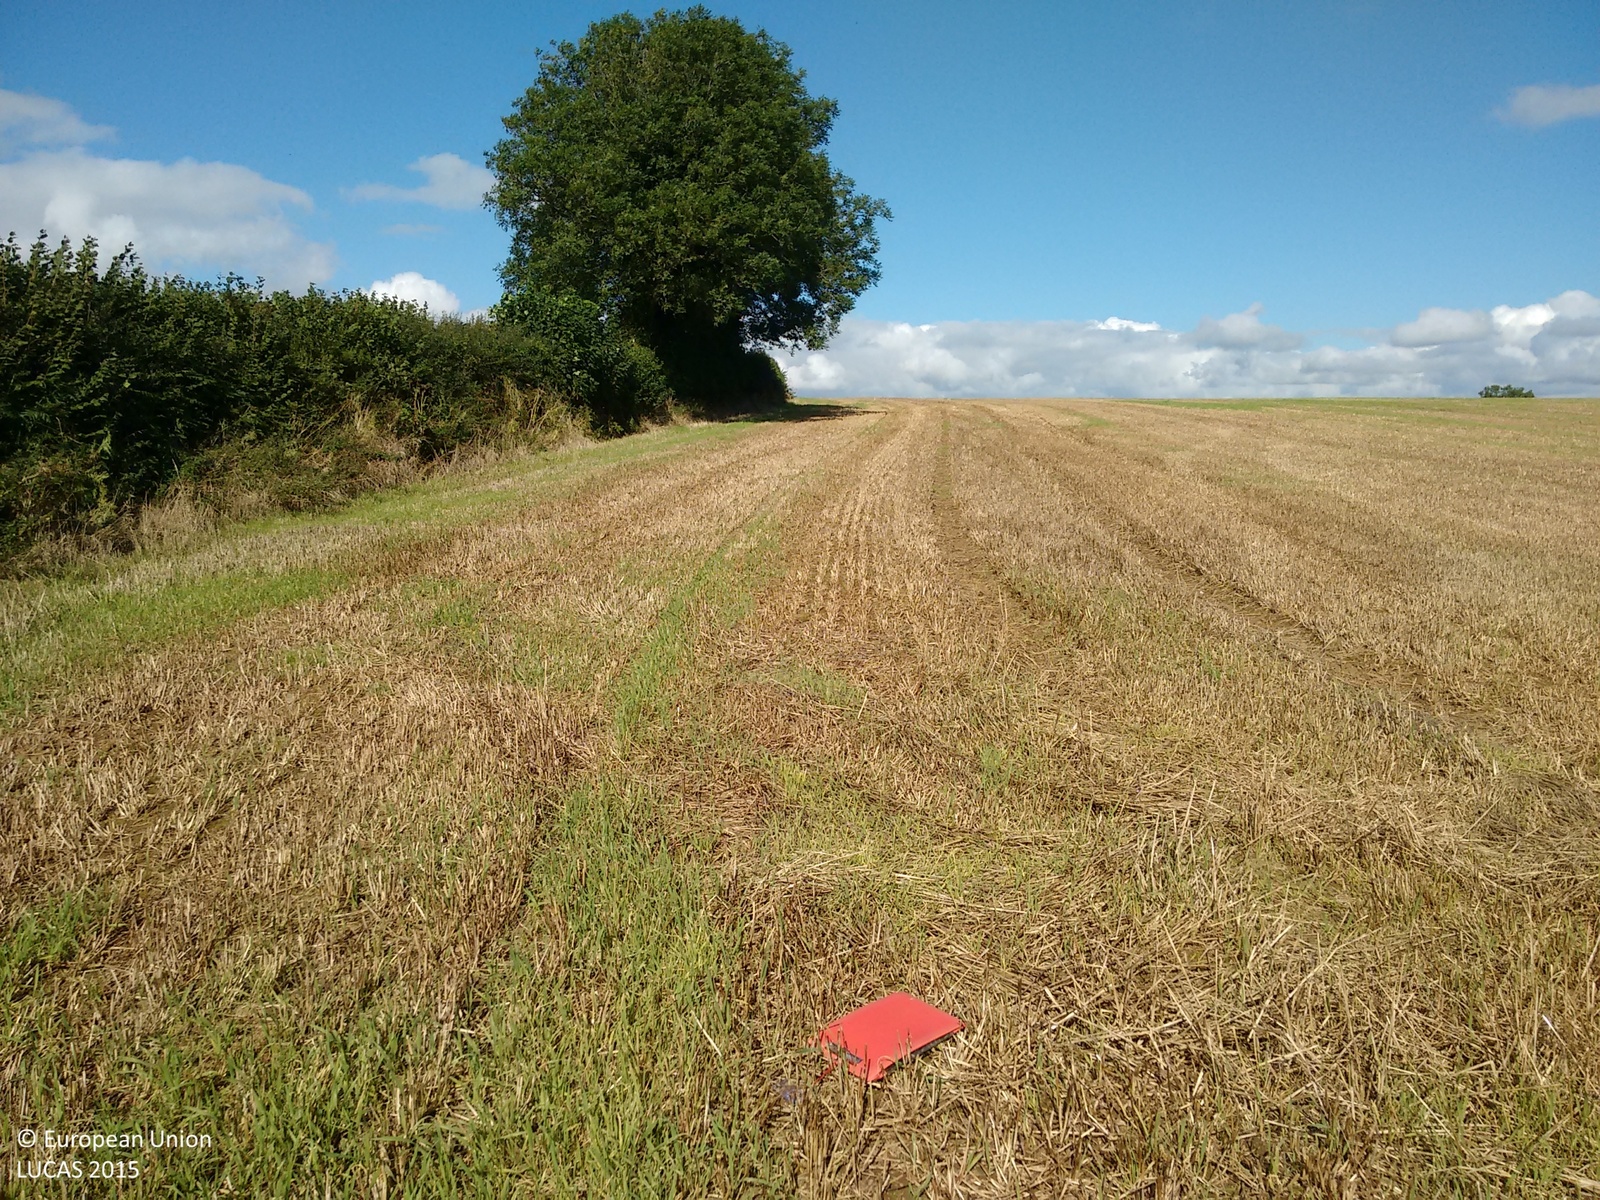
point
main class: Cropland
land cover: Common wheat
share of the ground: 10 - 25 %
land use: Agriculture (excluding fallow land and kitchen gardens)
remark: Harvested field
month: September
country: GB
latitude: 50.5573
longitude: -4.4301
